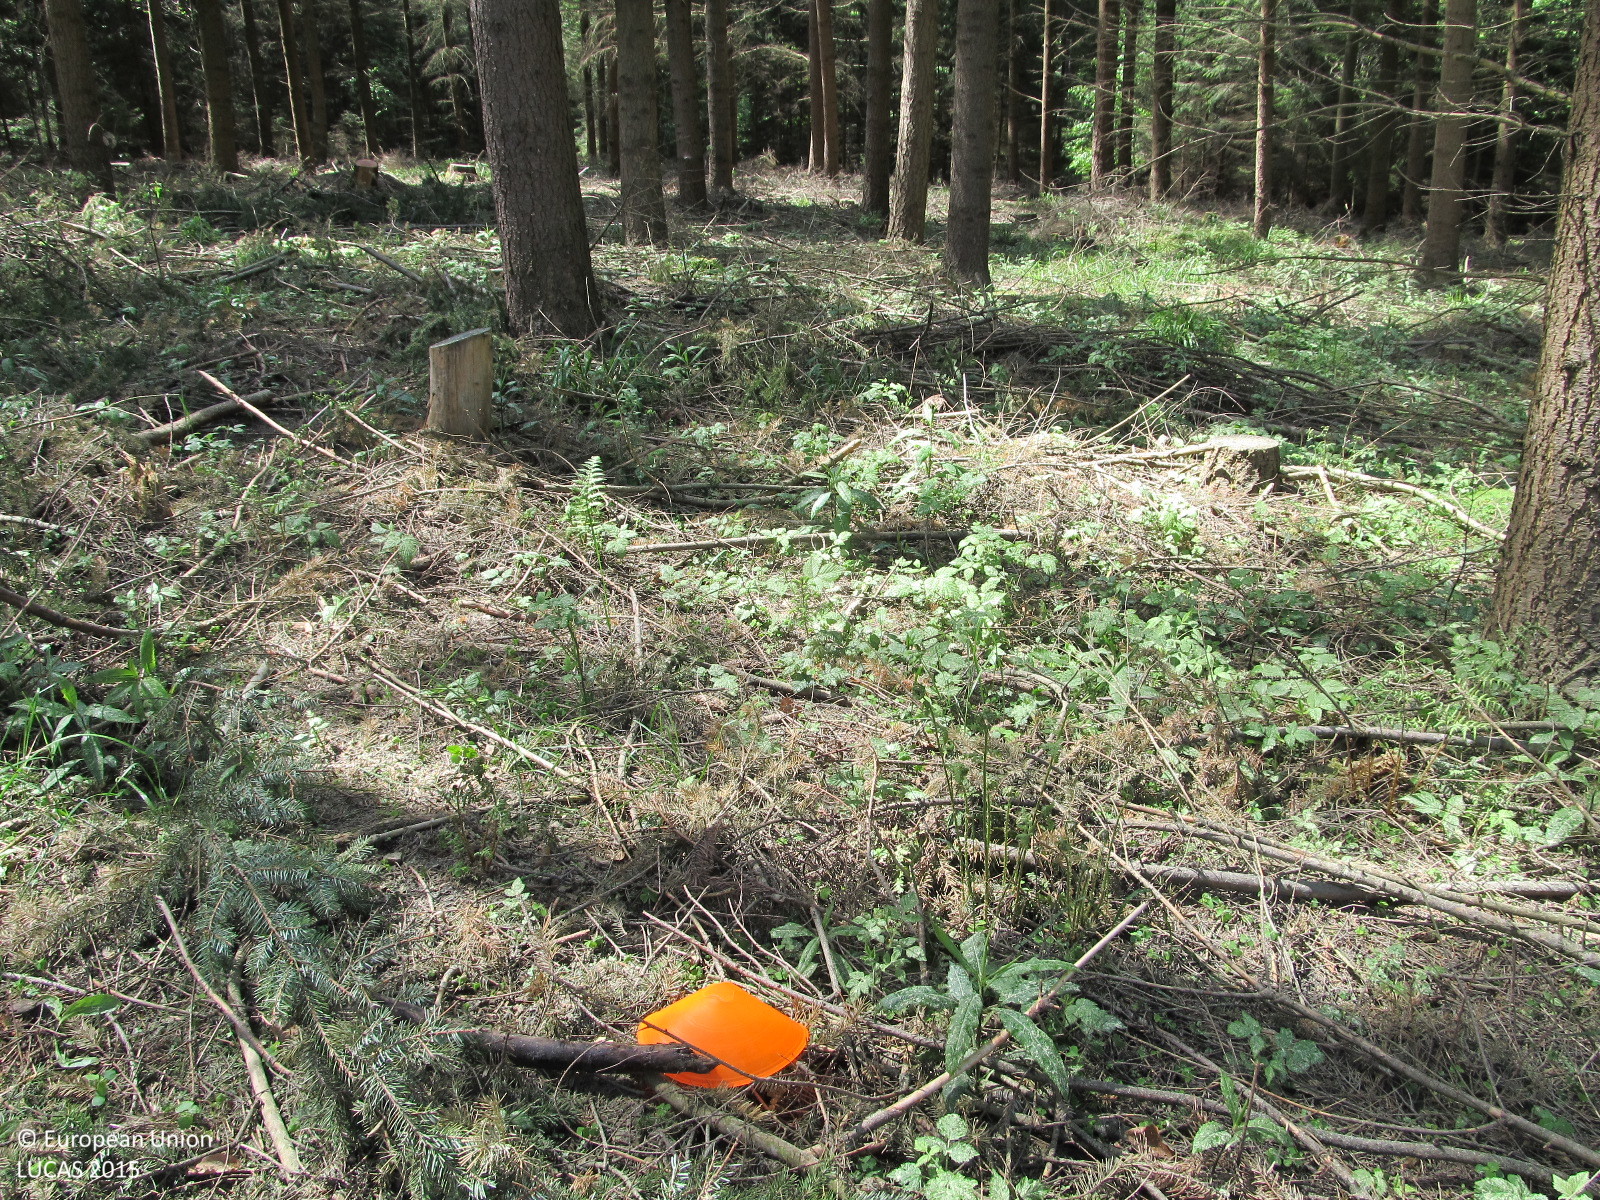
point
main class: Woodland
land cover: Spruce dominated coniferous woodland
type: hemiboreal forest and nemoral coniferous forest and mixed broadleaved-coniferous forest
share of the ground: > 75 %
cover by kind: coniferous forest trees 75 %, broadleaved forest trees 20 %, herbaceous plants 5 %
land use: Forestry
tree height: > 5 m
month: May
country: AT
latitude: 48.5723
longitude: 15.5190
